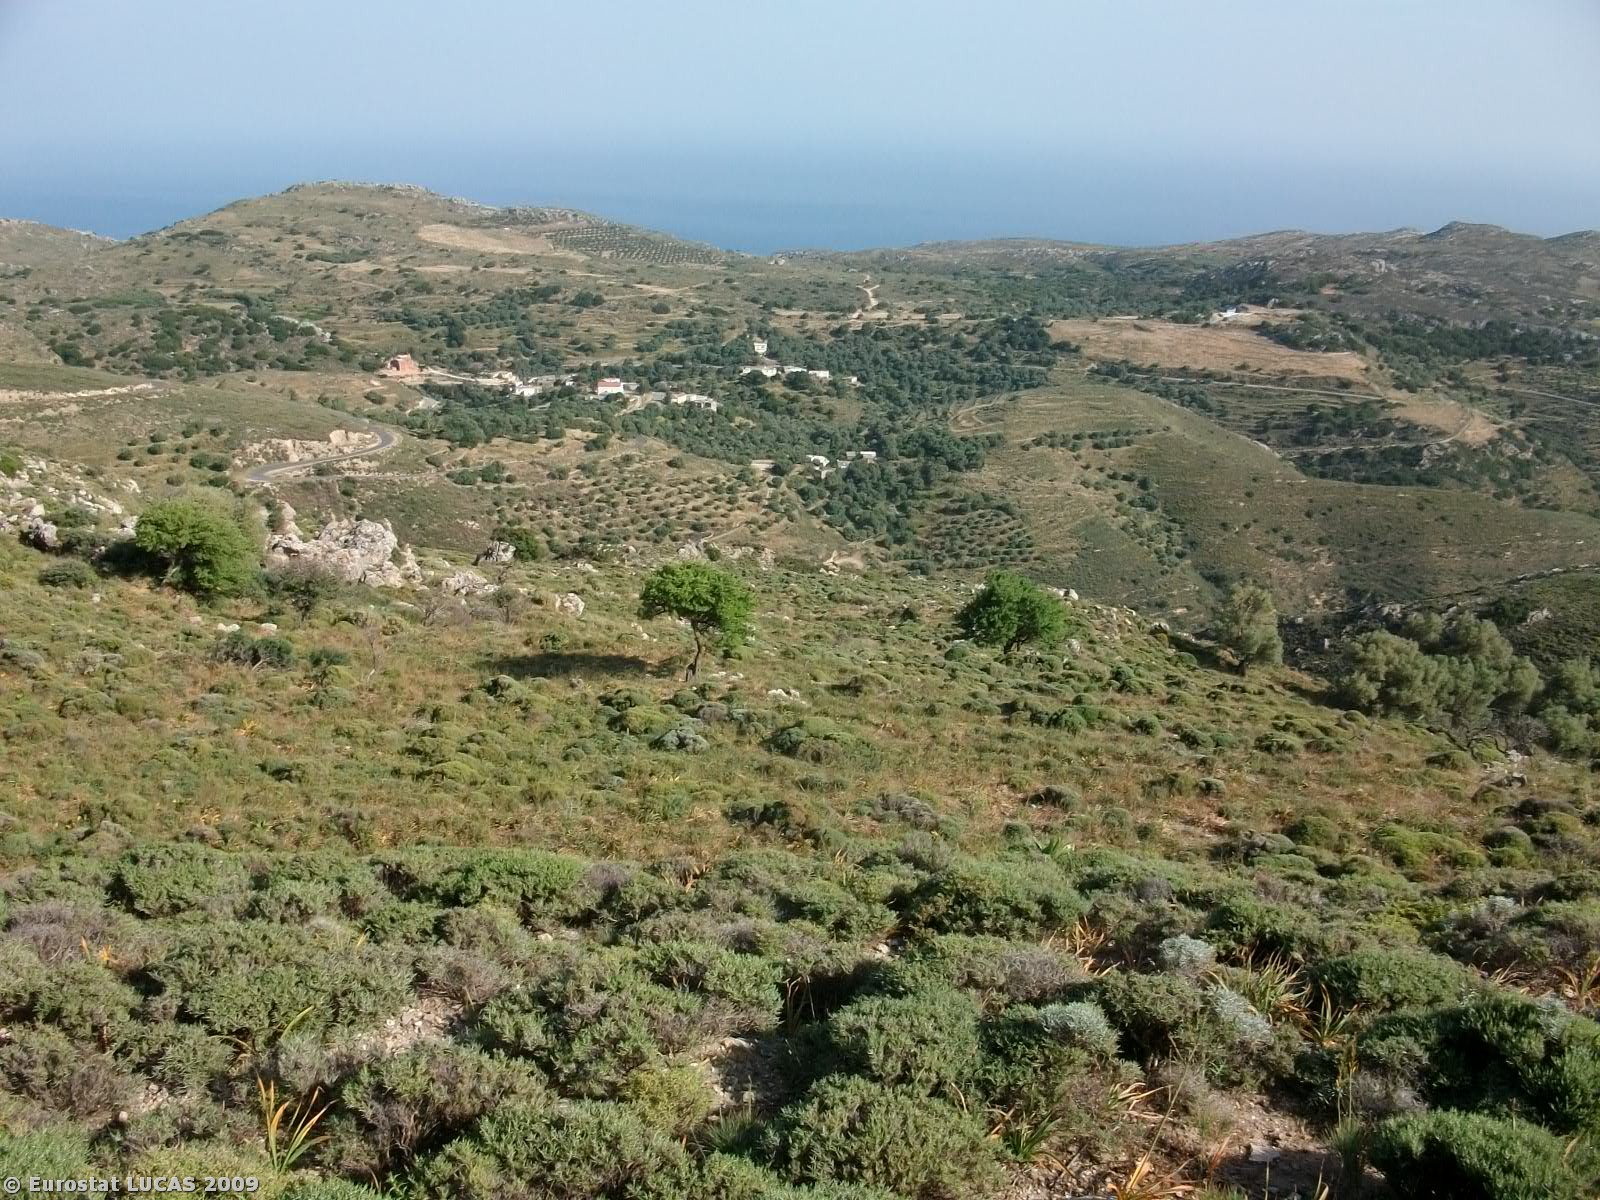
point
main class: Shrubland
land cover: Shrubland without tree cover
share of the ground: > 75 %
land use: Agriculture (excluding fallow land and kitchen gardens)
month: June
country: GR
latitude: 35.2721
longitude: 23.7541
